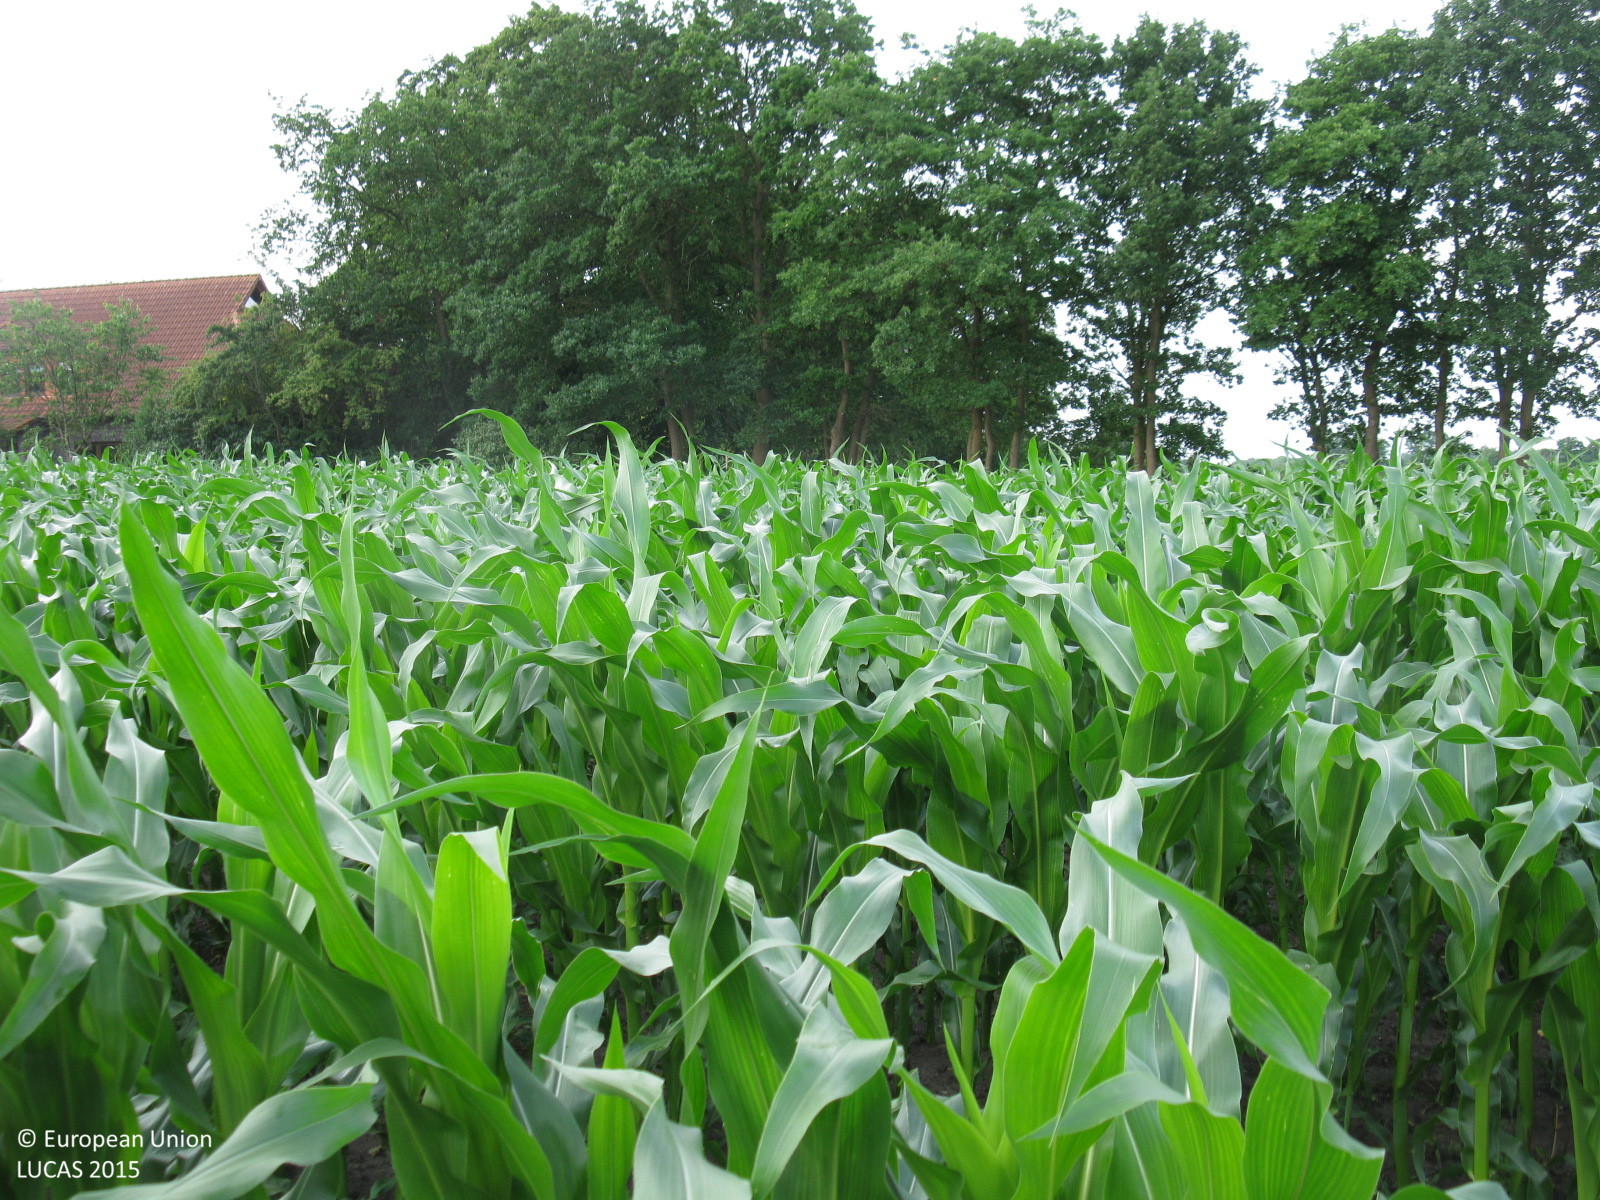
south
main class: Cropland
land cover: Maize
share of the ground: > 75 %
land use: Agriculture (excluding fallow land and kitchen gardens)
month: July
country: DE
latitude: 53.4193
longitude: 7.8791
